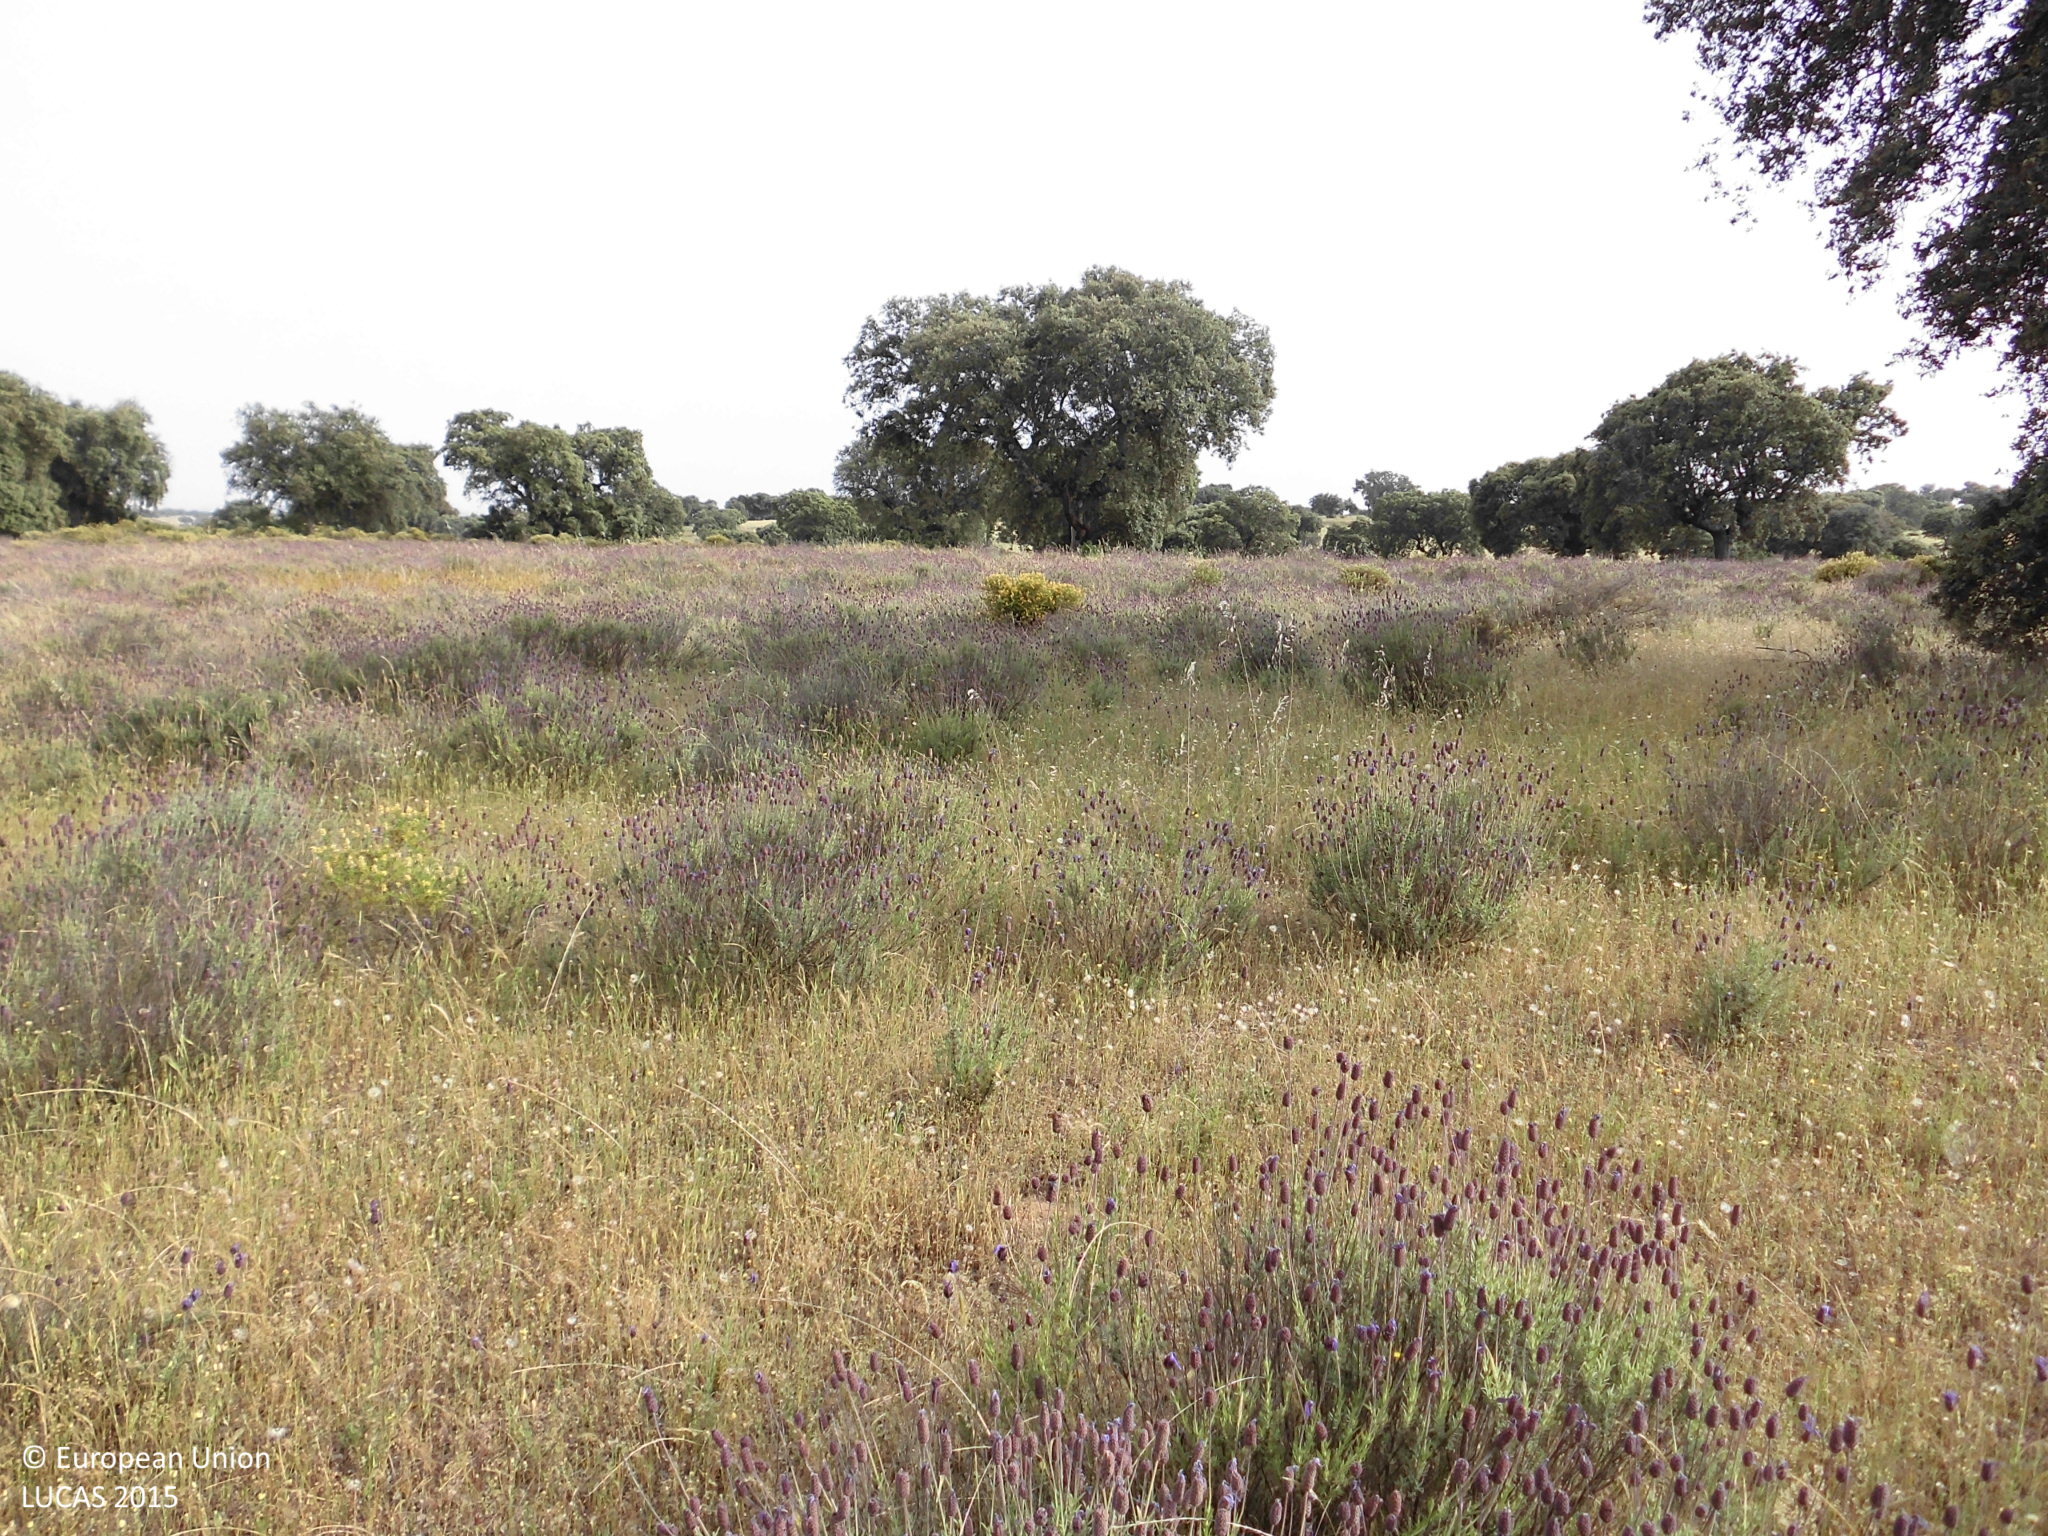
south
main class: Woodland
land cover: Broadleaved woodland
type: broadleaved evergreen forest
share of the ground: 25 - 50 %
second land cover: Grassland without tree/shrub cover
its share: > 75 %
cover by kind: herbaceous plants 55 %, broadleaved forest trees 30 %, shrubs 15 %
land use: Forestry
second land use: Agriculture (excluding fallow land and kitchen gardens)
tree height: > 5 m
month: May
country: ES
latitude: 39.6575
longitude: -6.1390
